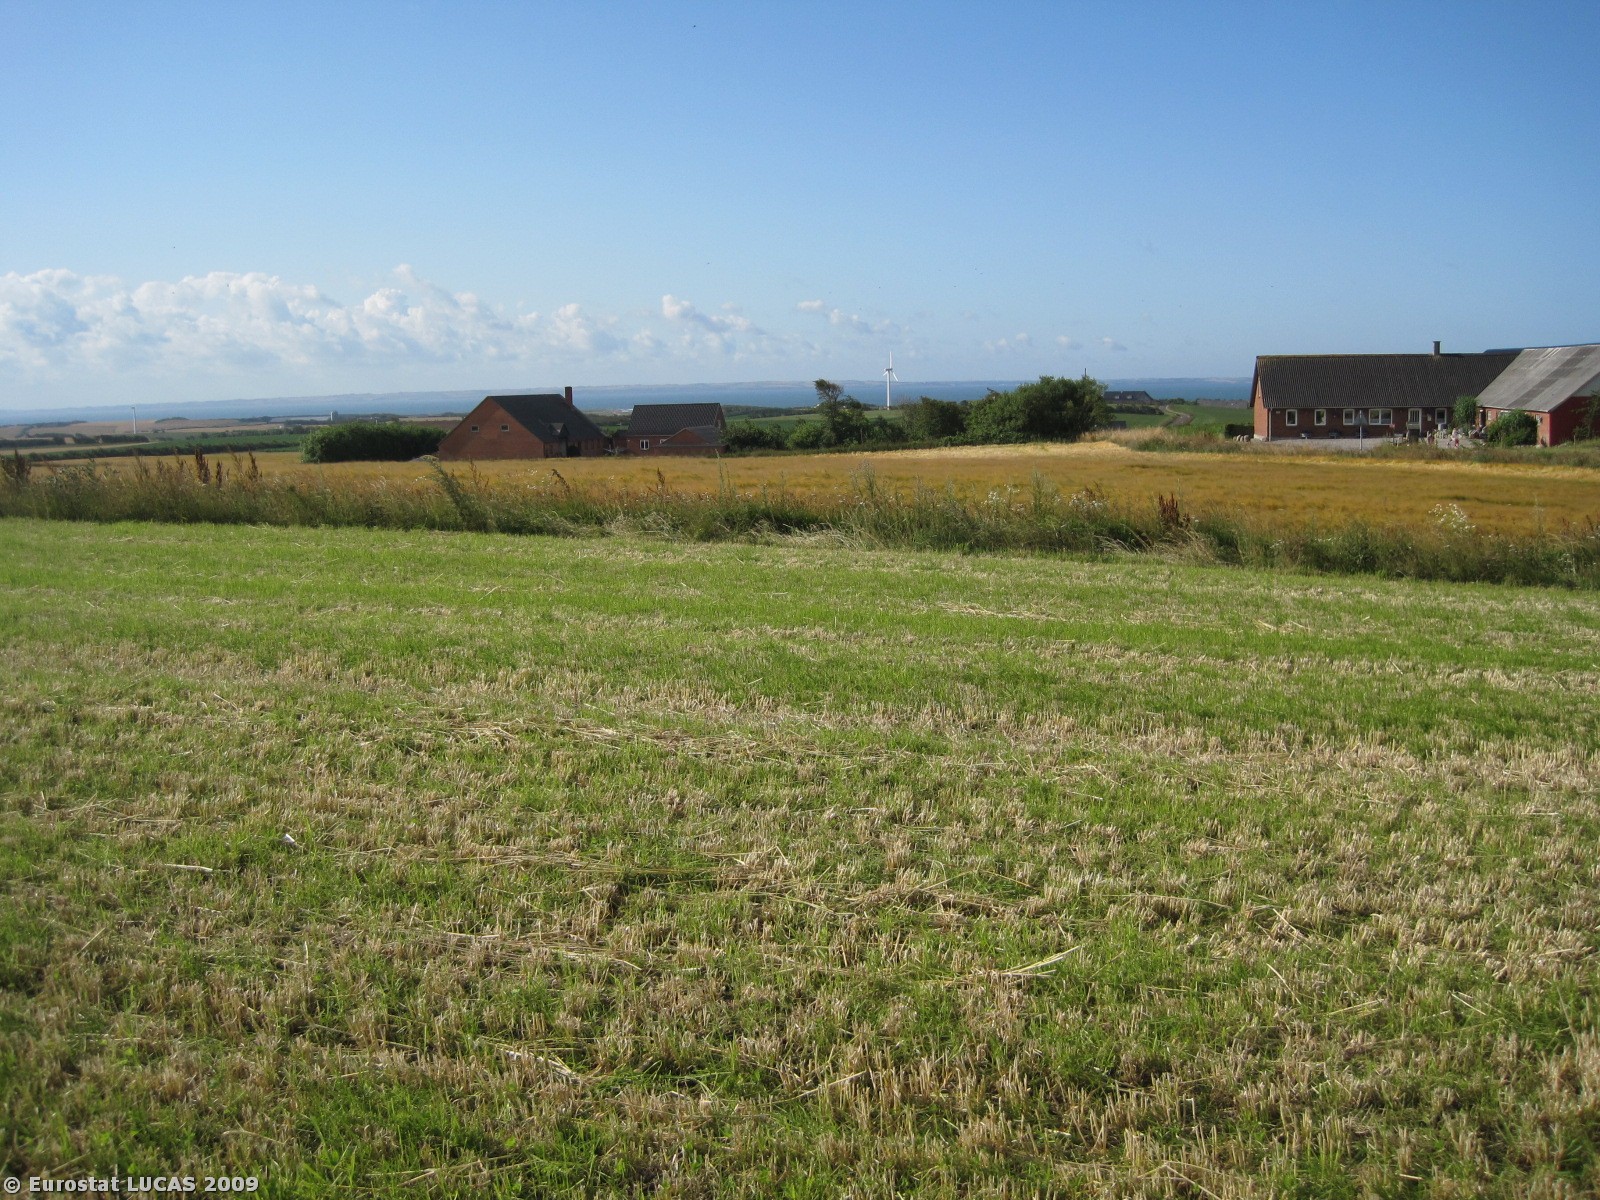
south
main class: Cropland
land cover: Barley
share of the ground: > 75 %
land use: Agriculture (excluding fallow land and kitchen gardens)
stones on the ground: < 10 %
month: July
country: DK
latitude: 56.7166
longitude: 8.3519
